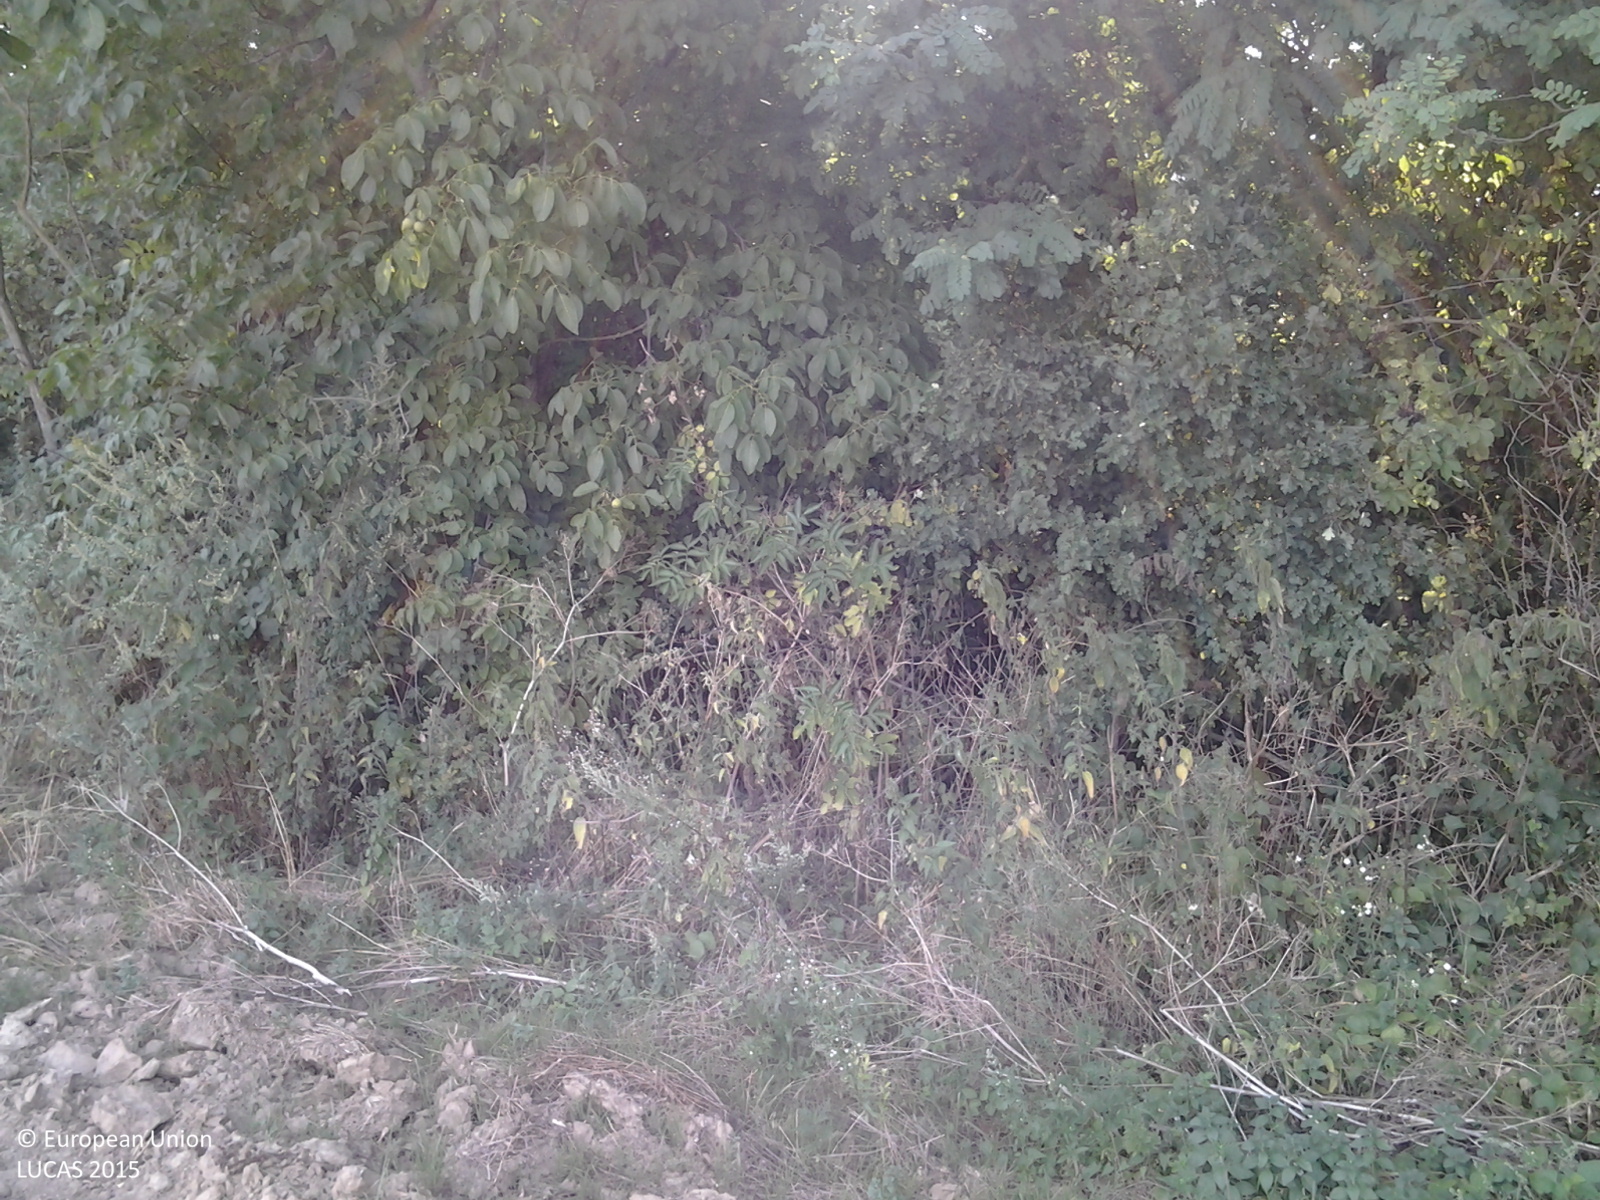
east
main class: Cropland
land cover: Rape and turnip rape
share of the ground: < 10 %
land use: Agriculture (excluding fallow land and kitchen gardens)
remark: Harvested field
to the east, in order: Rape and turnip rape; Broadleaved woodland; Tracks; Broadleaved woodland
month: August
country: HU
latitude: 46.6413
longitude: 17.0712
